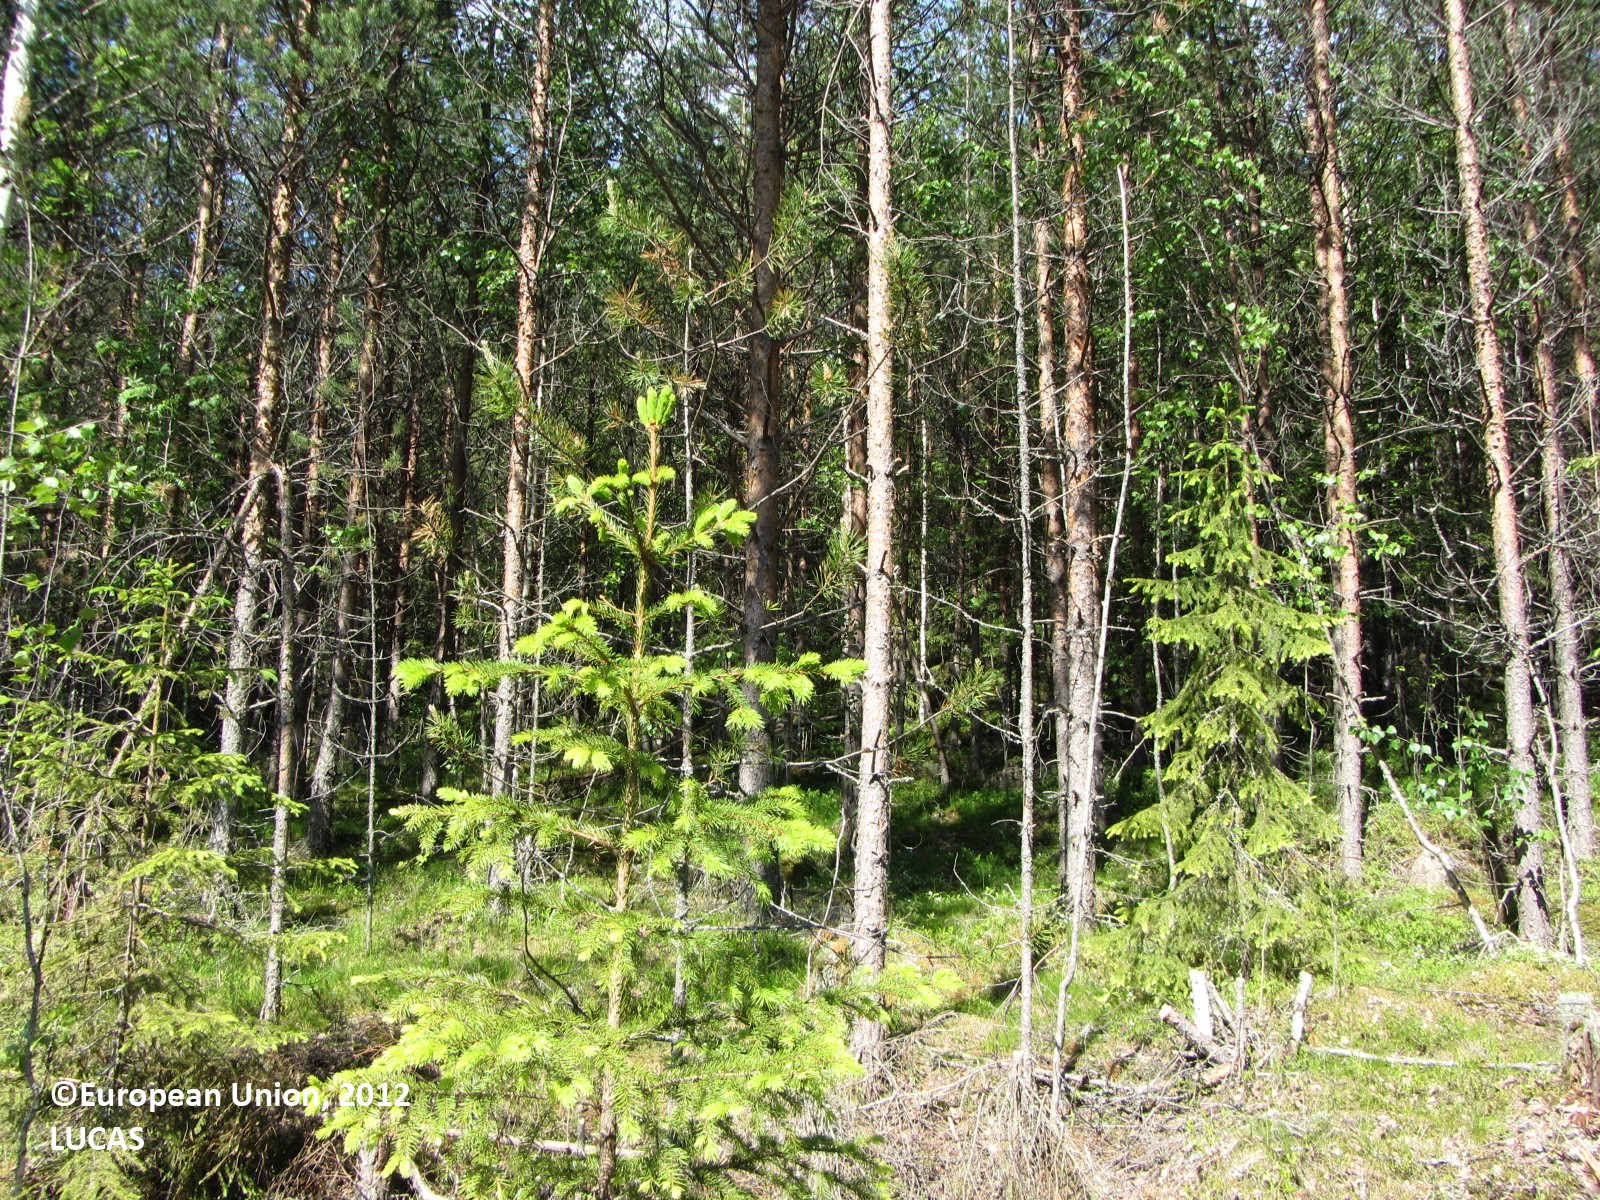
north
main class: Woodland
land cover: Other mixed woodland
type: boreal forest
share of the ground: > 75 %
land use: Forestry
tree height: > 5 m
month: June
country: FI
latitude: 62.3112
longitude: 24.8564
